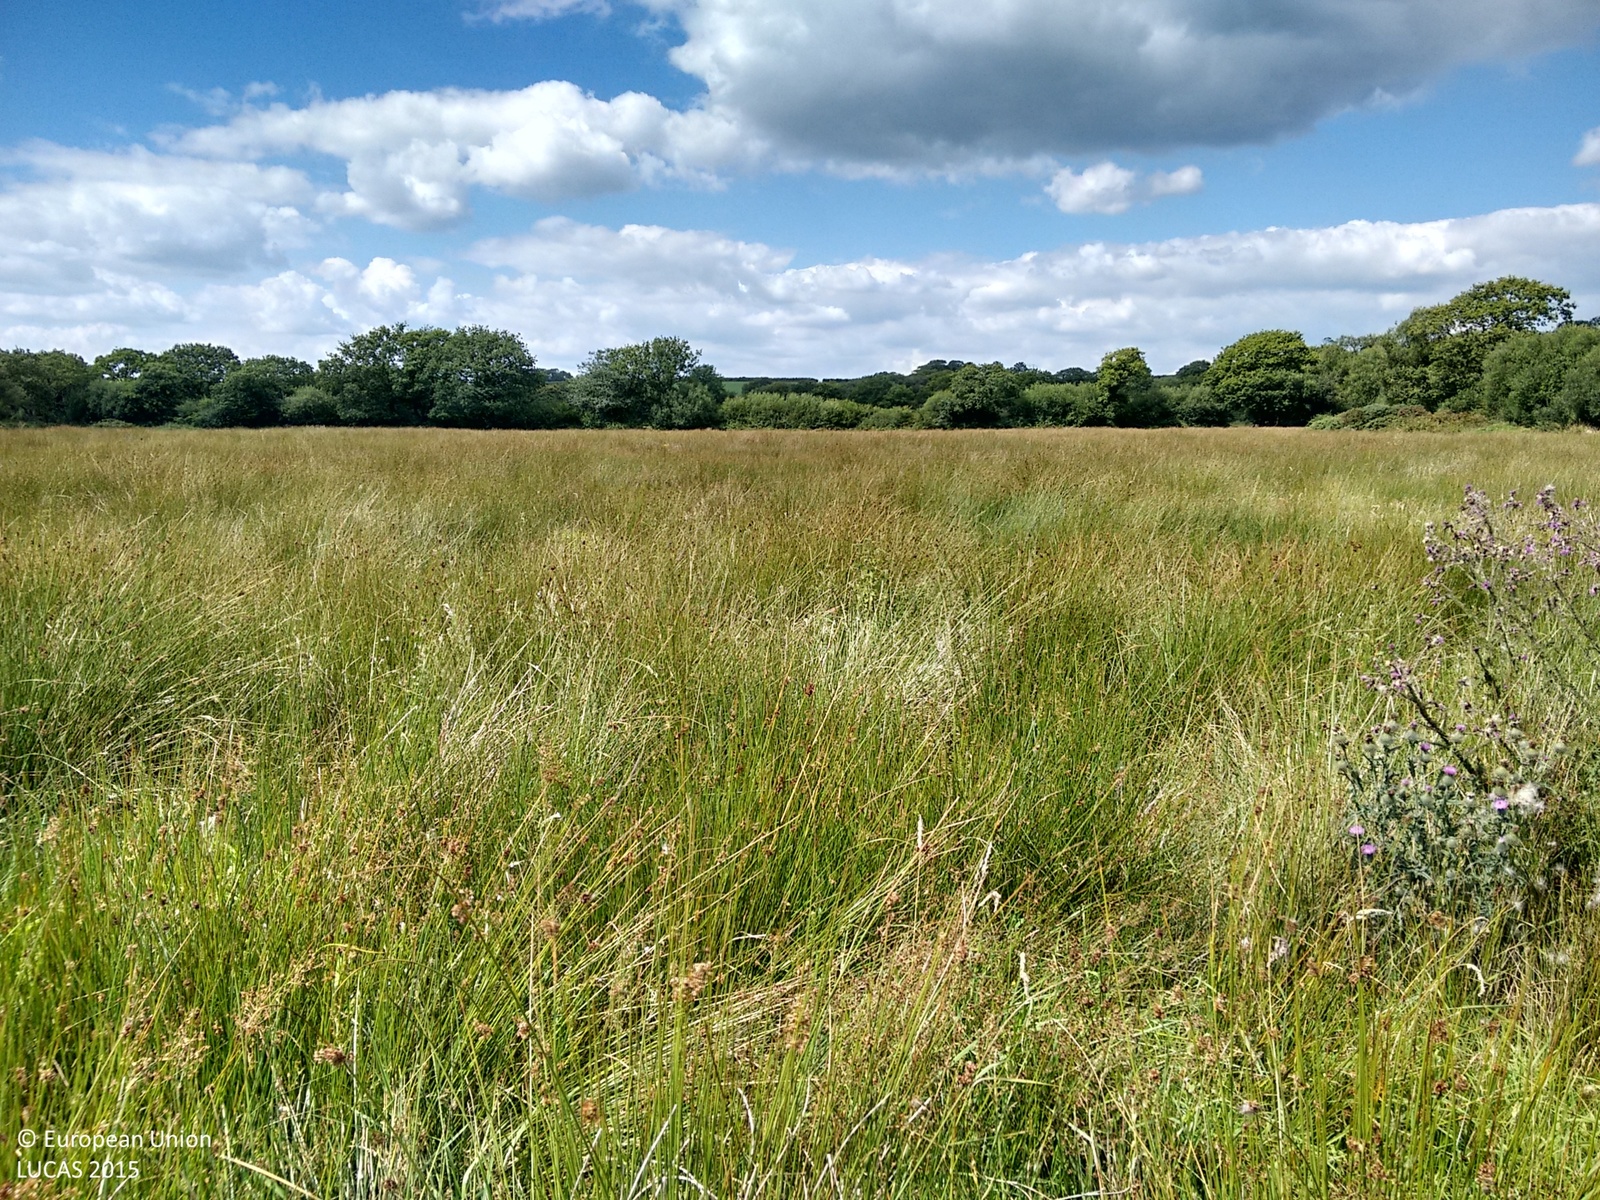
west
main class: Grassland
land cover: Grassland without tree/shrub cover
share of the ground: > 75 %
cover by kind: herbaceous plants 100 %
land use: Agriculture (excluding fallow land and kitchen gardens)
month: August
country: GB
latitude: 51.8158
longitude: -4.4510
